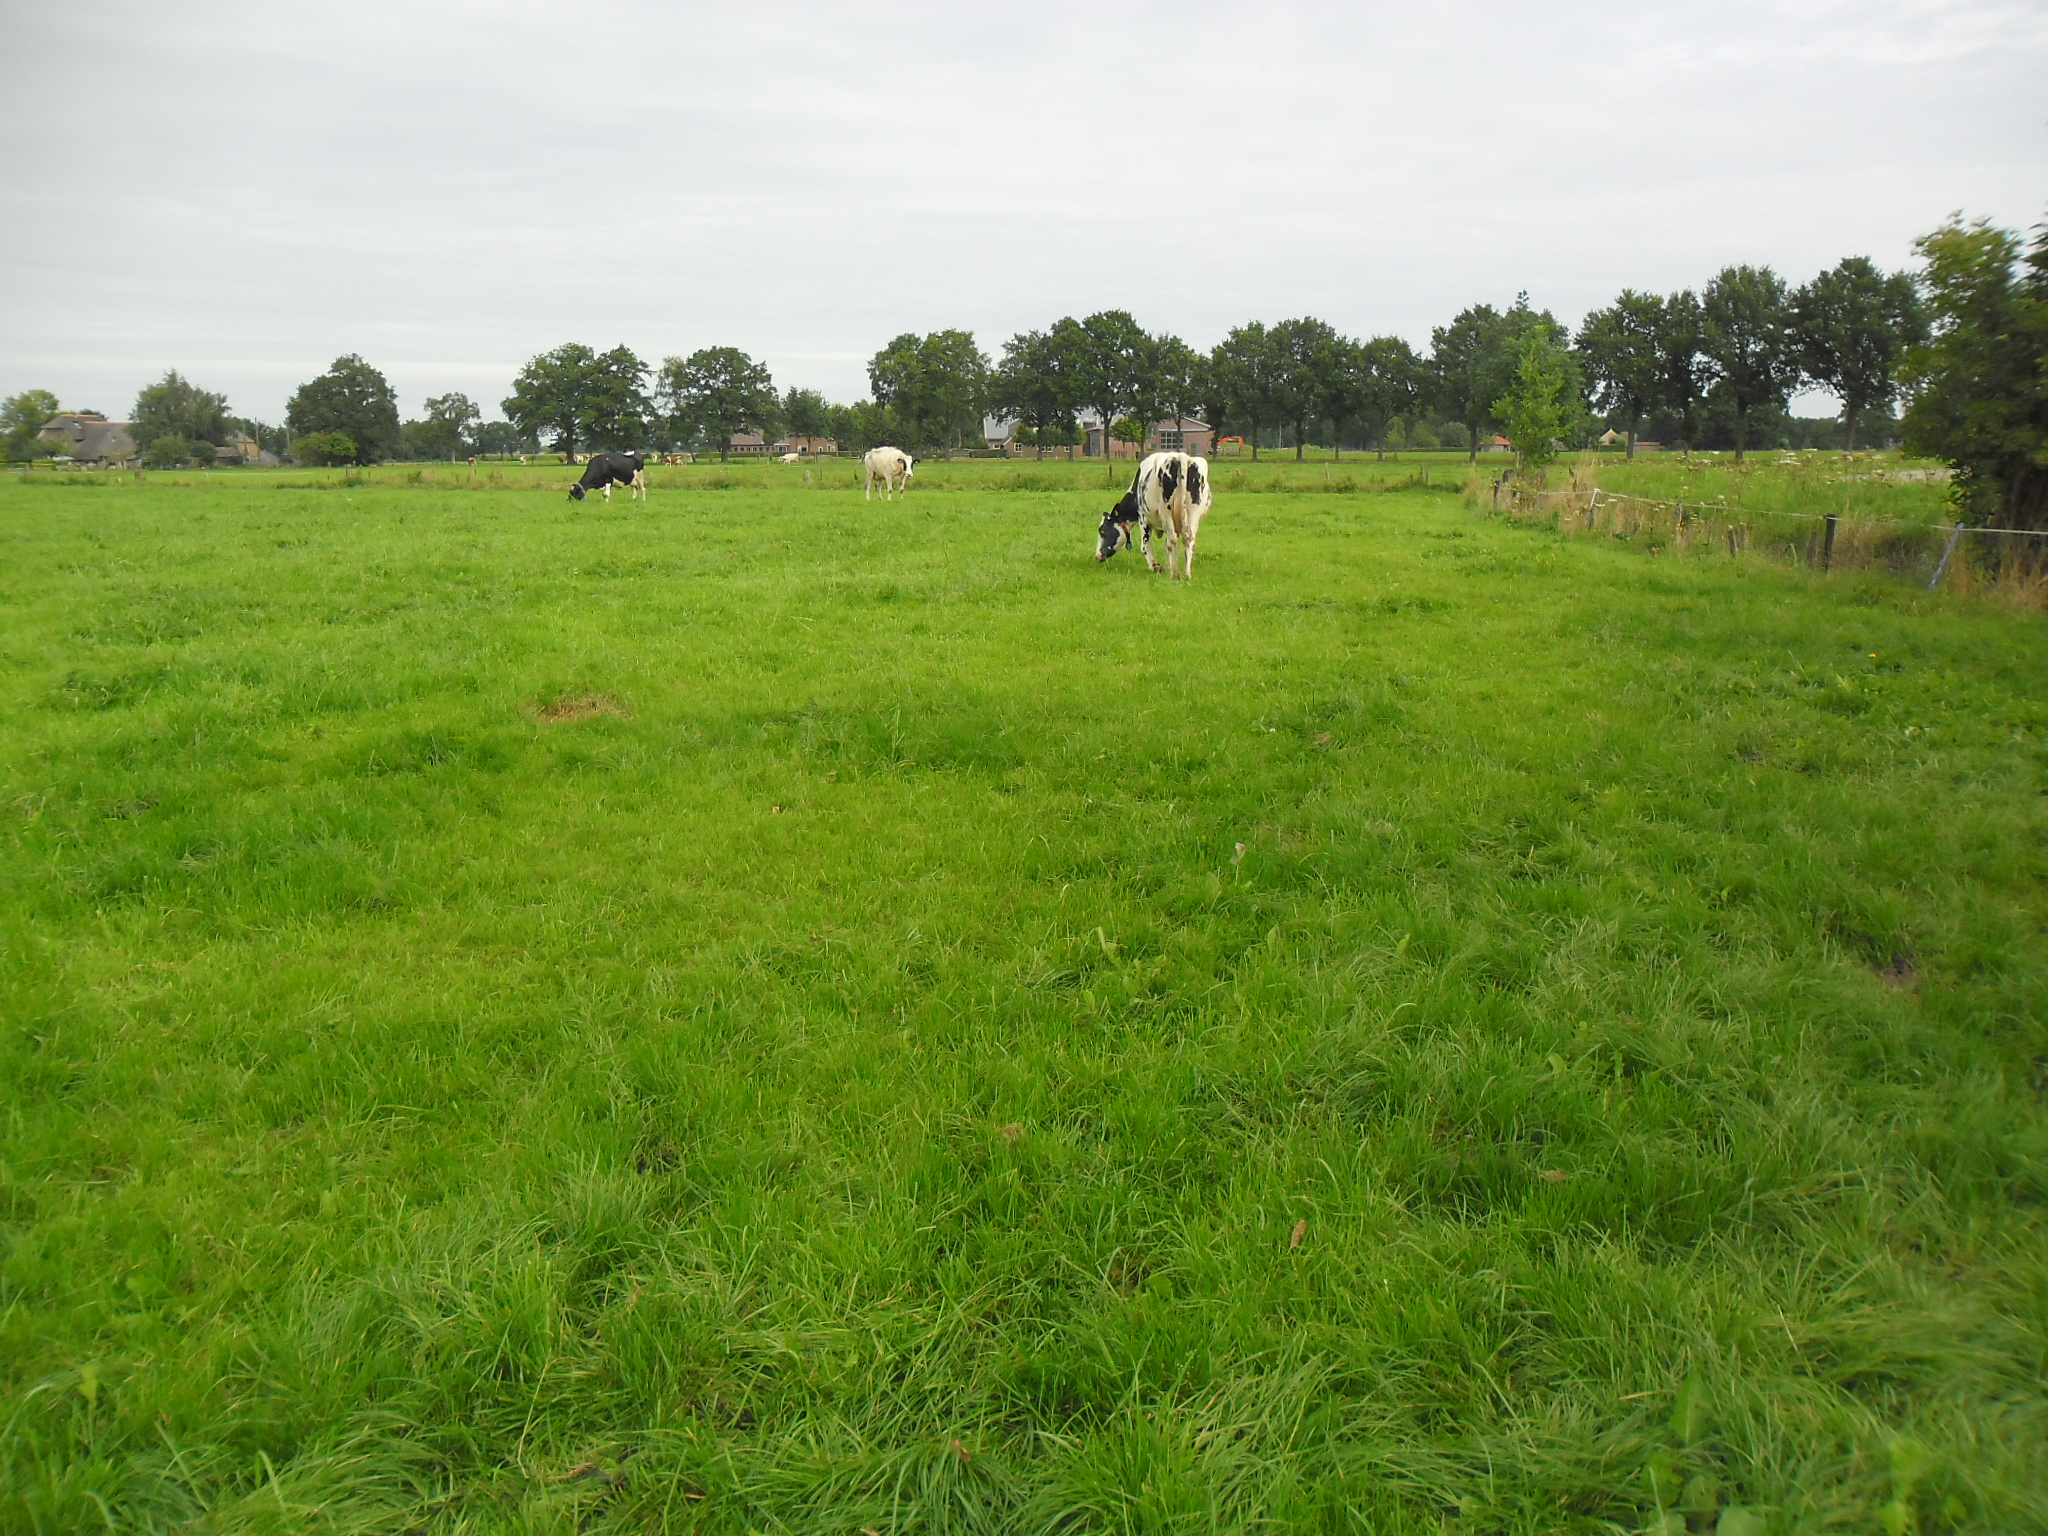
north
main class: Grassland
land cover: Grassland without tree/shrub cover
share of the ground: > 75 %
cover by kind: herbaceous plants 100 %
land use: Agriculture (excluding fallow land and kitchen gardens)
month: August
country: NL
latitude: 52.4442
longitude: 6.2479
